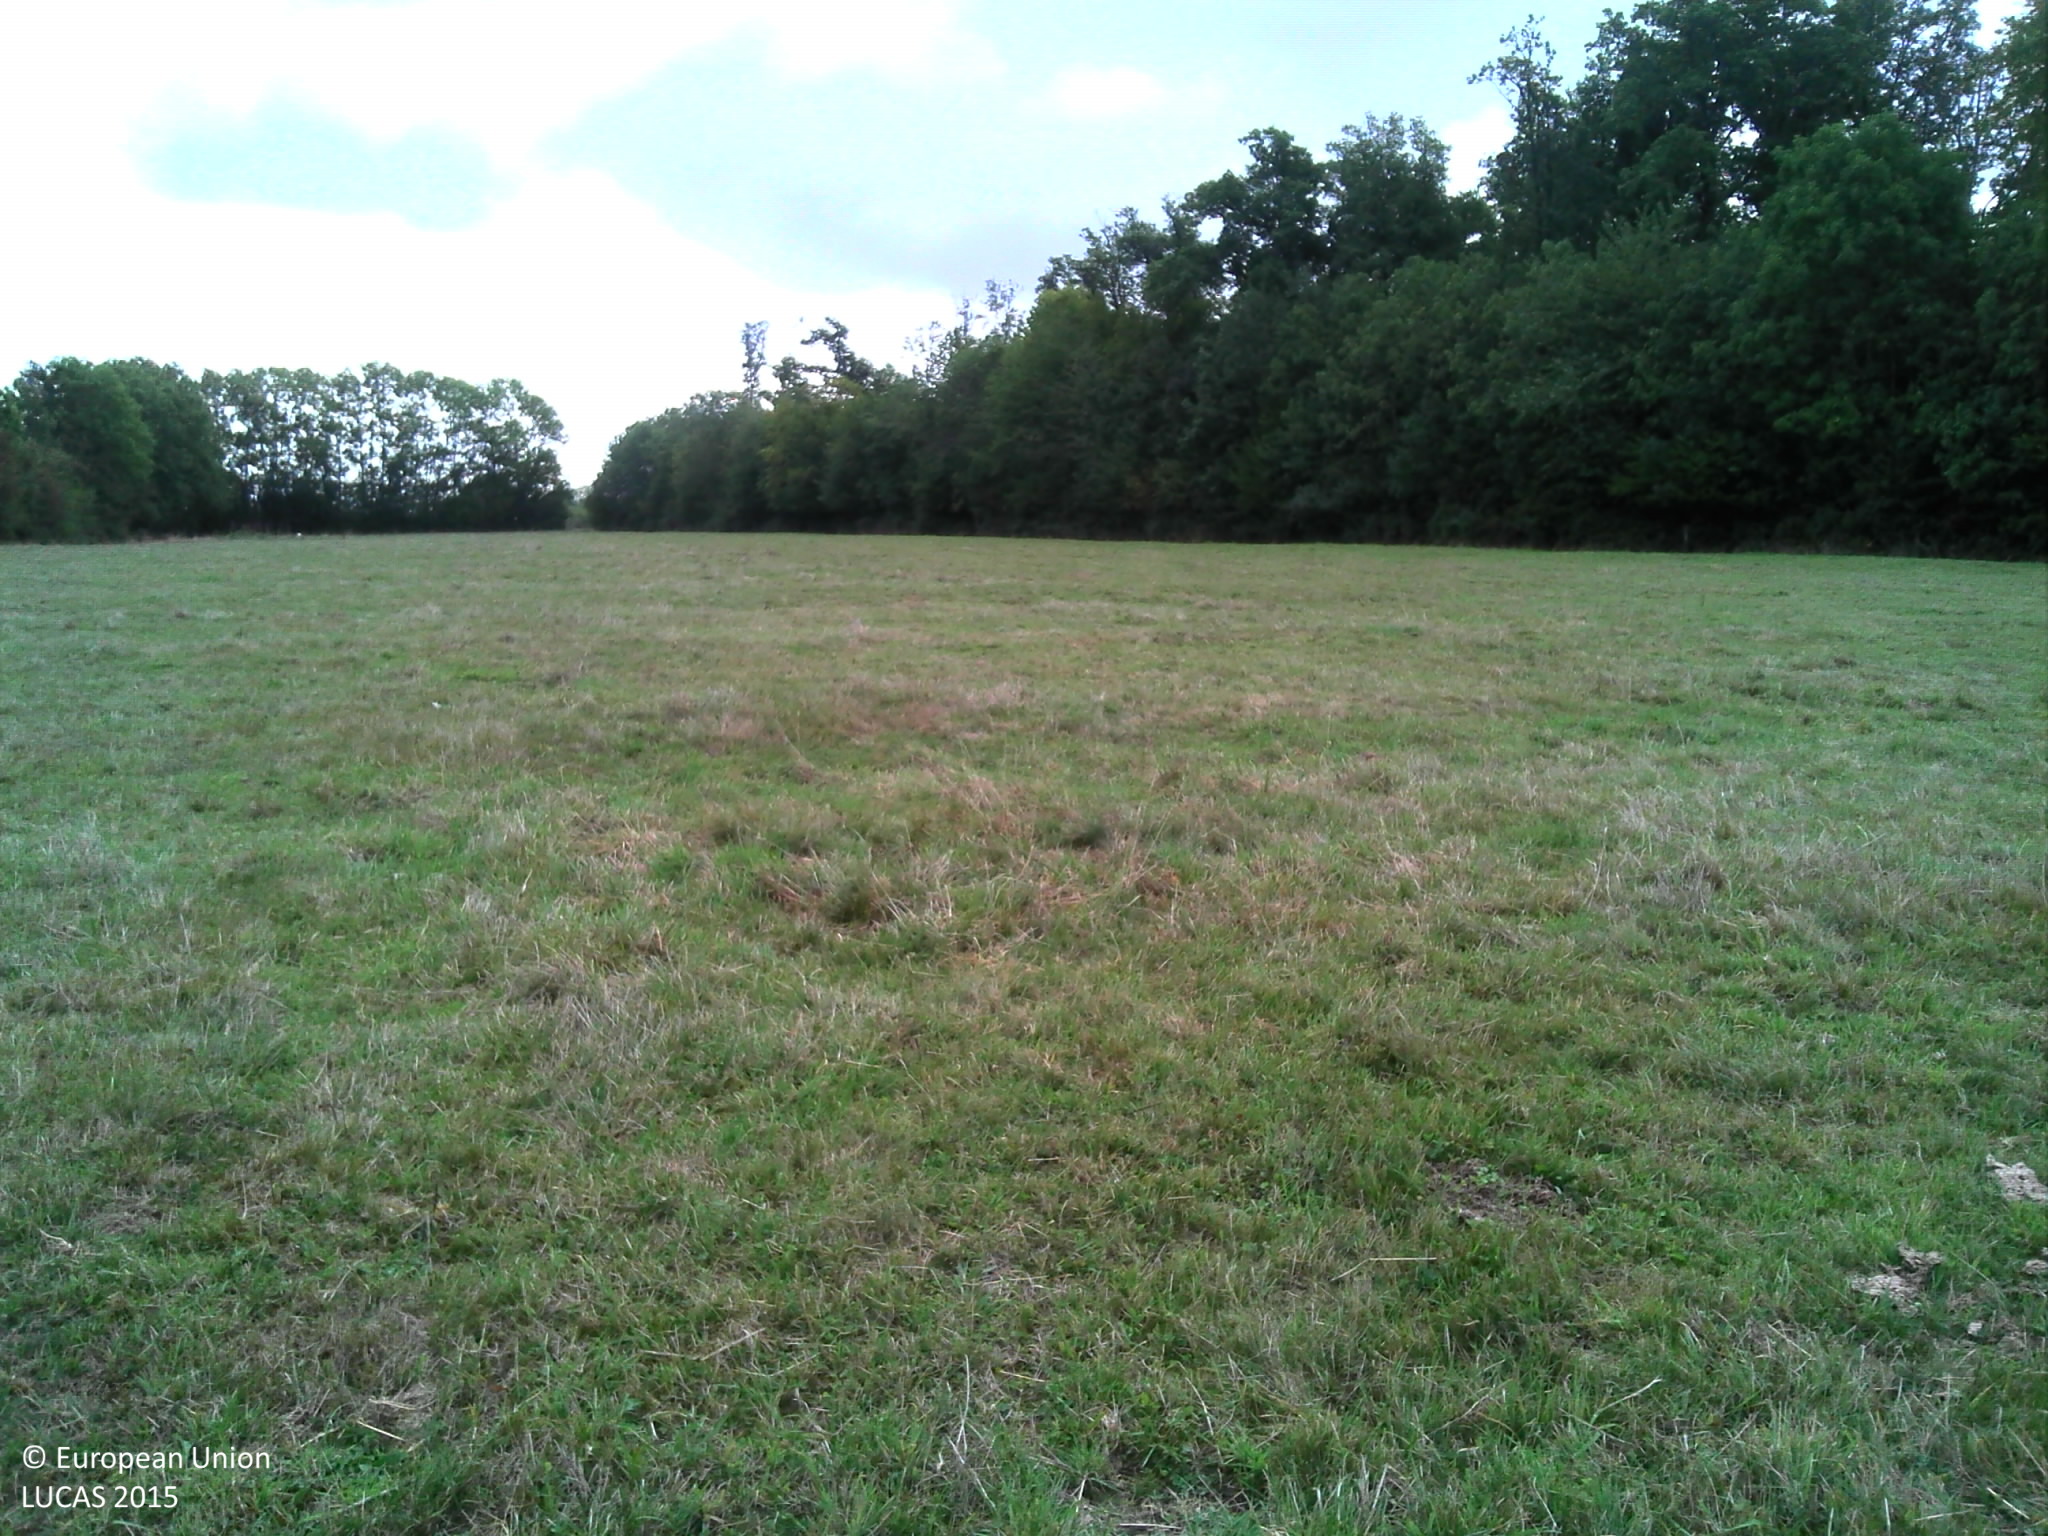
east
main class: Grassland
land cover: Grassland without tree/shrub cover
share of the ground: > 75 %
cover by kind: herbaceous plants 95 %, consolidated bare surface 5 %
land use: Agriculture (excluding fallow land and kitchen gardens)
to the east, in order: Grassland without tree/shrub cover; Broadleaved woodland; Fences; Grass margins; Tracks; Grassland without tree/shrub cover
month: September
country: FR
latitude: 48.5532
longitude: 6.1661
